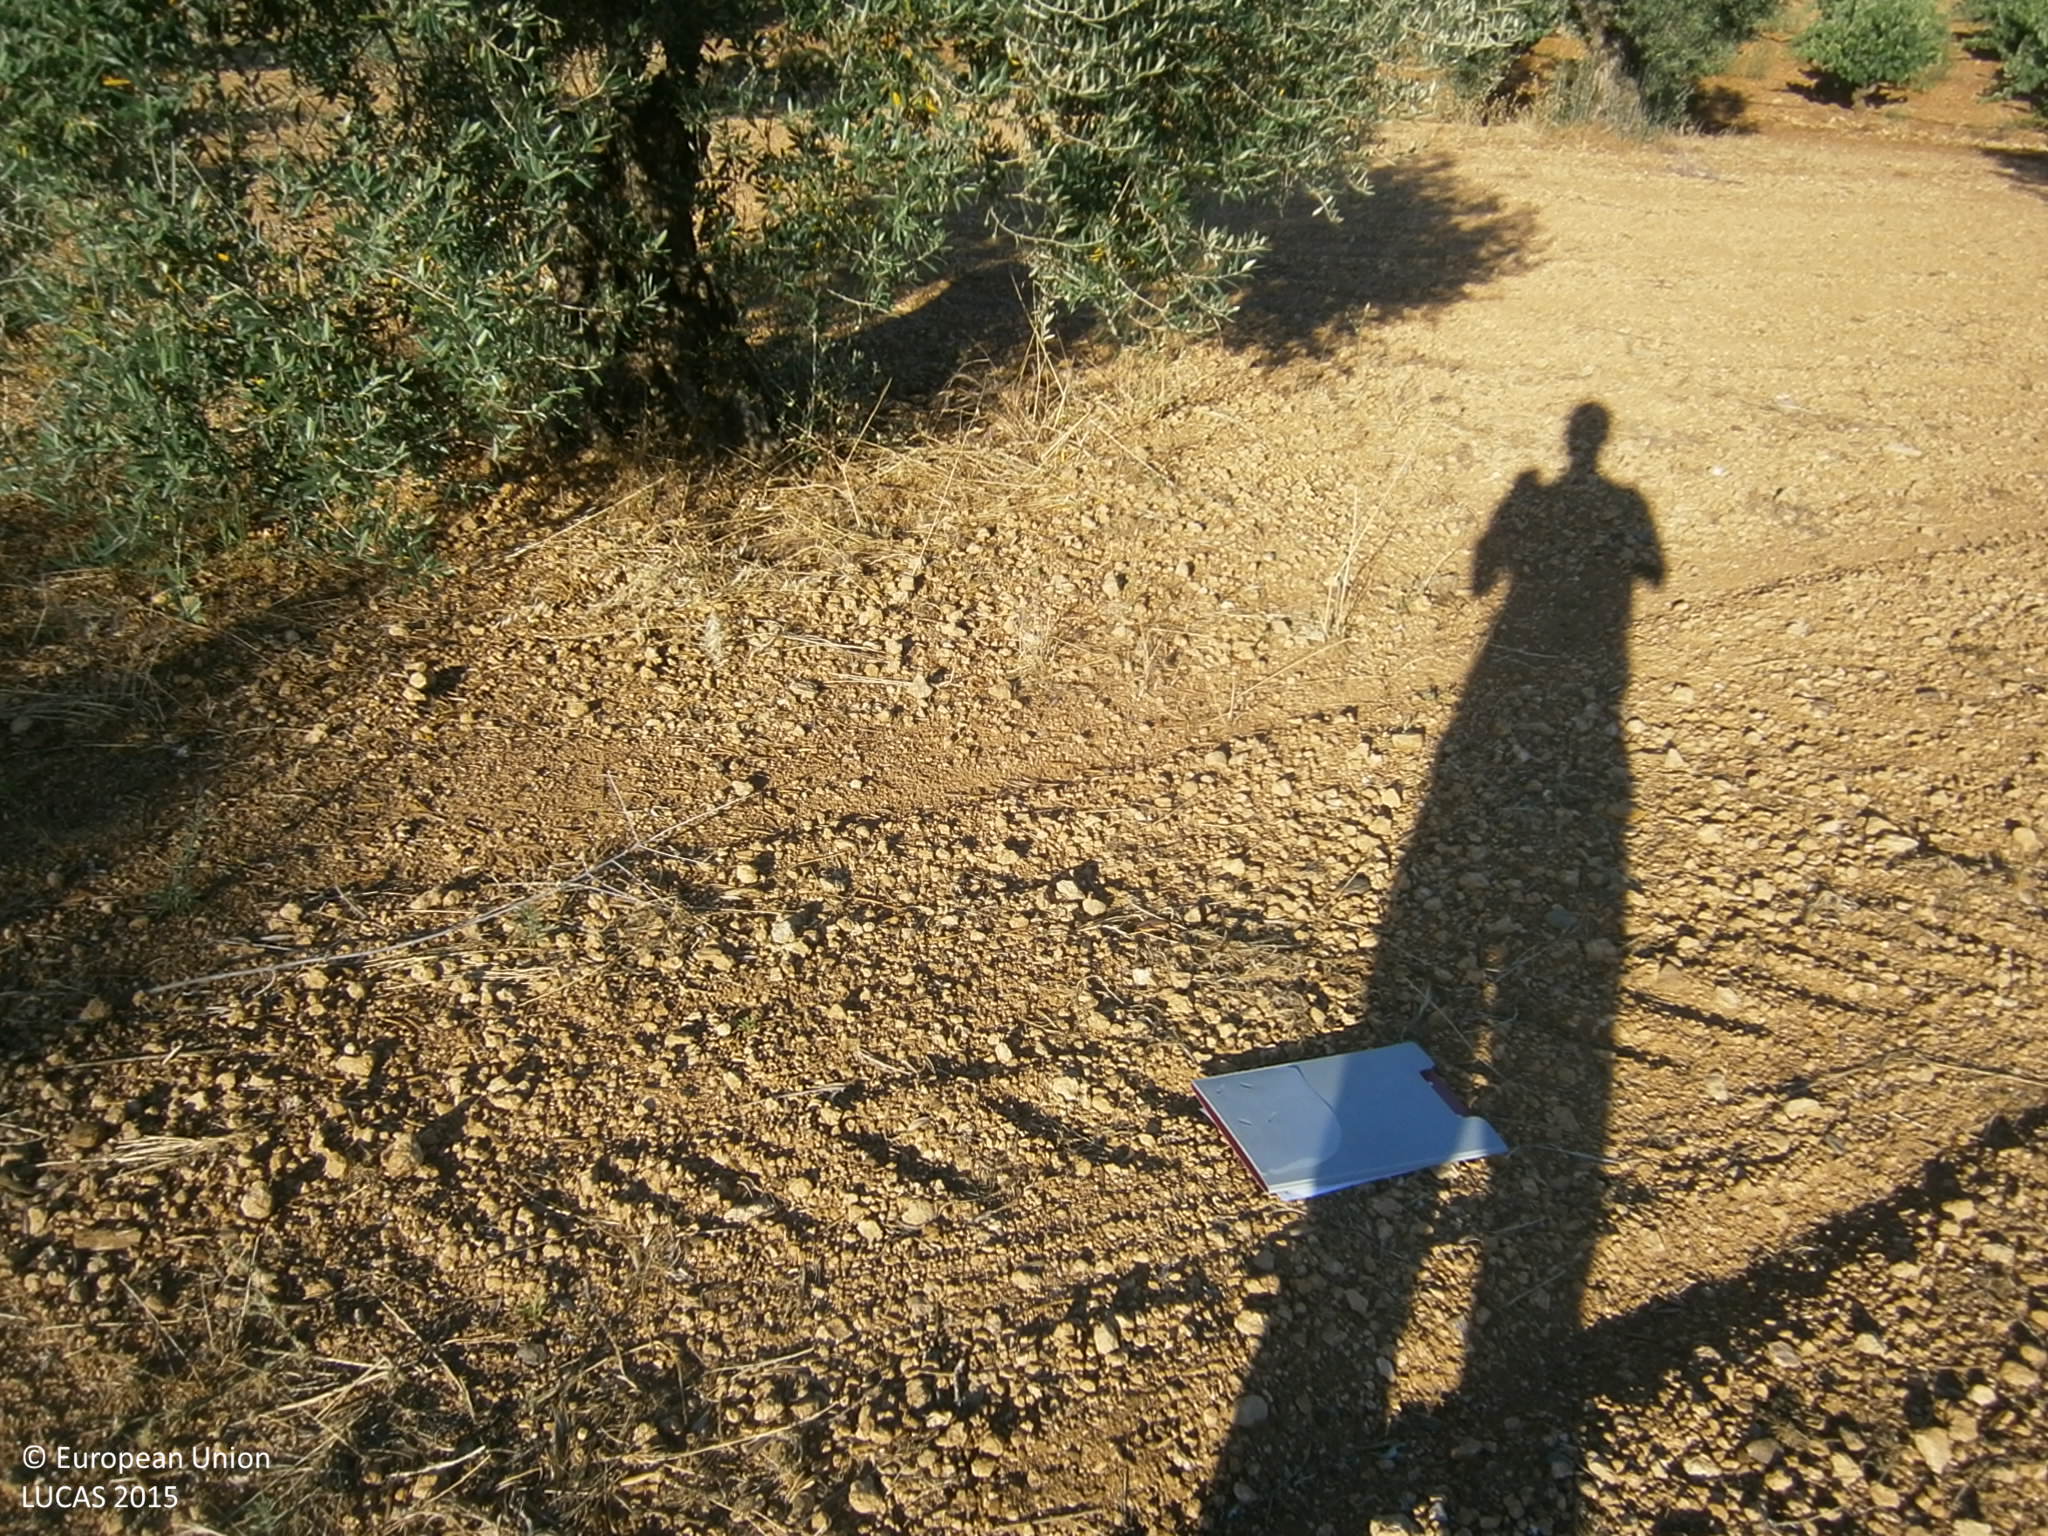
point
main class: Cropland
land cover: Olive groves
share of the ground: 10 - 25 %
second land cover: Other bare soil
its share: > 75 %
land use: Agriculture (excluding fallow land and kitchen gardens)
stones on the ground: 10 - 25 %
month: June
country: ES
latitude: 38.7135
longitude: -6.7023
